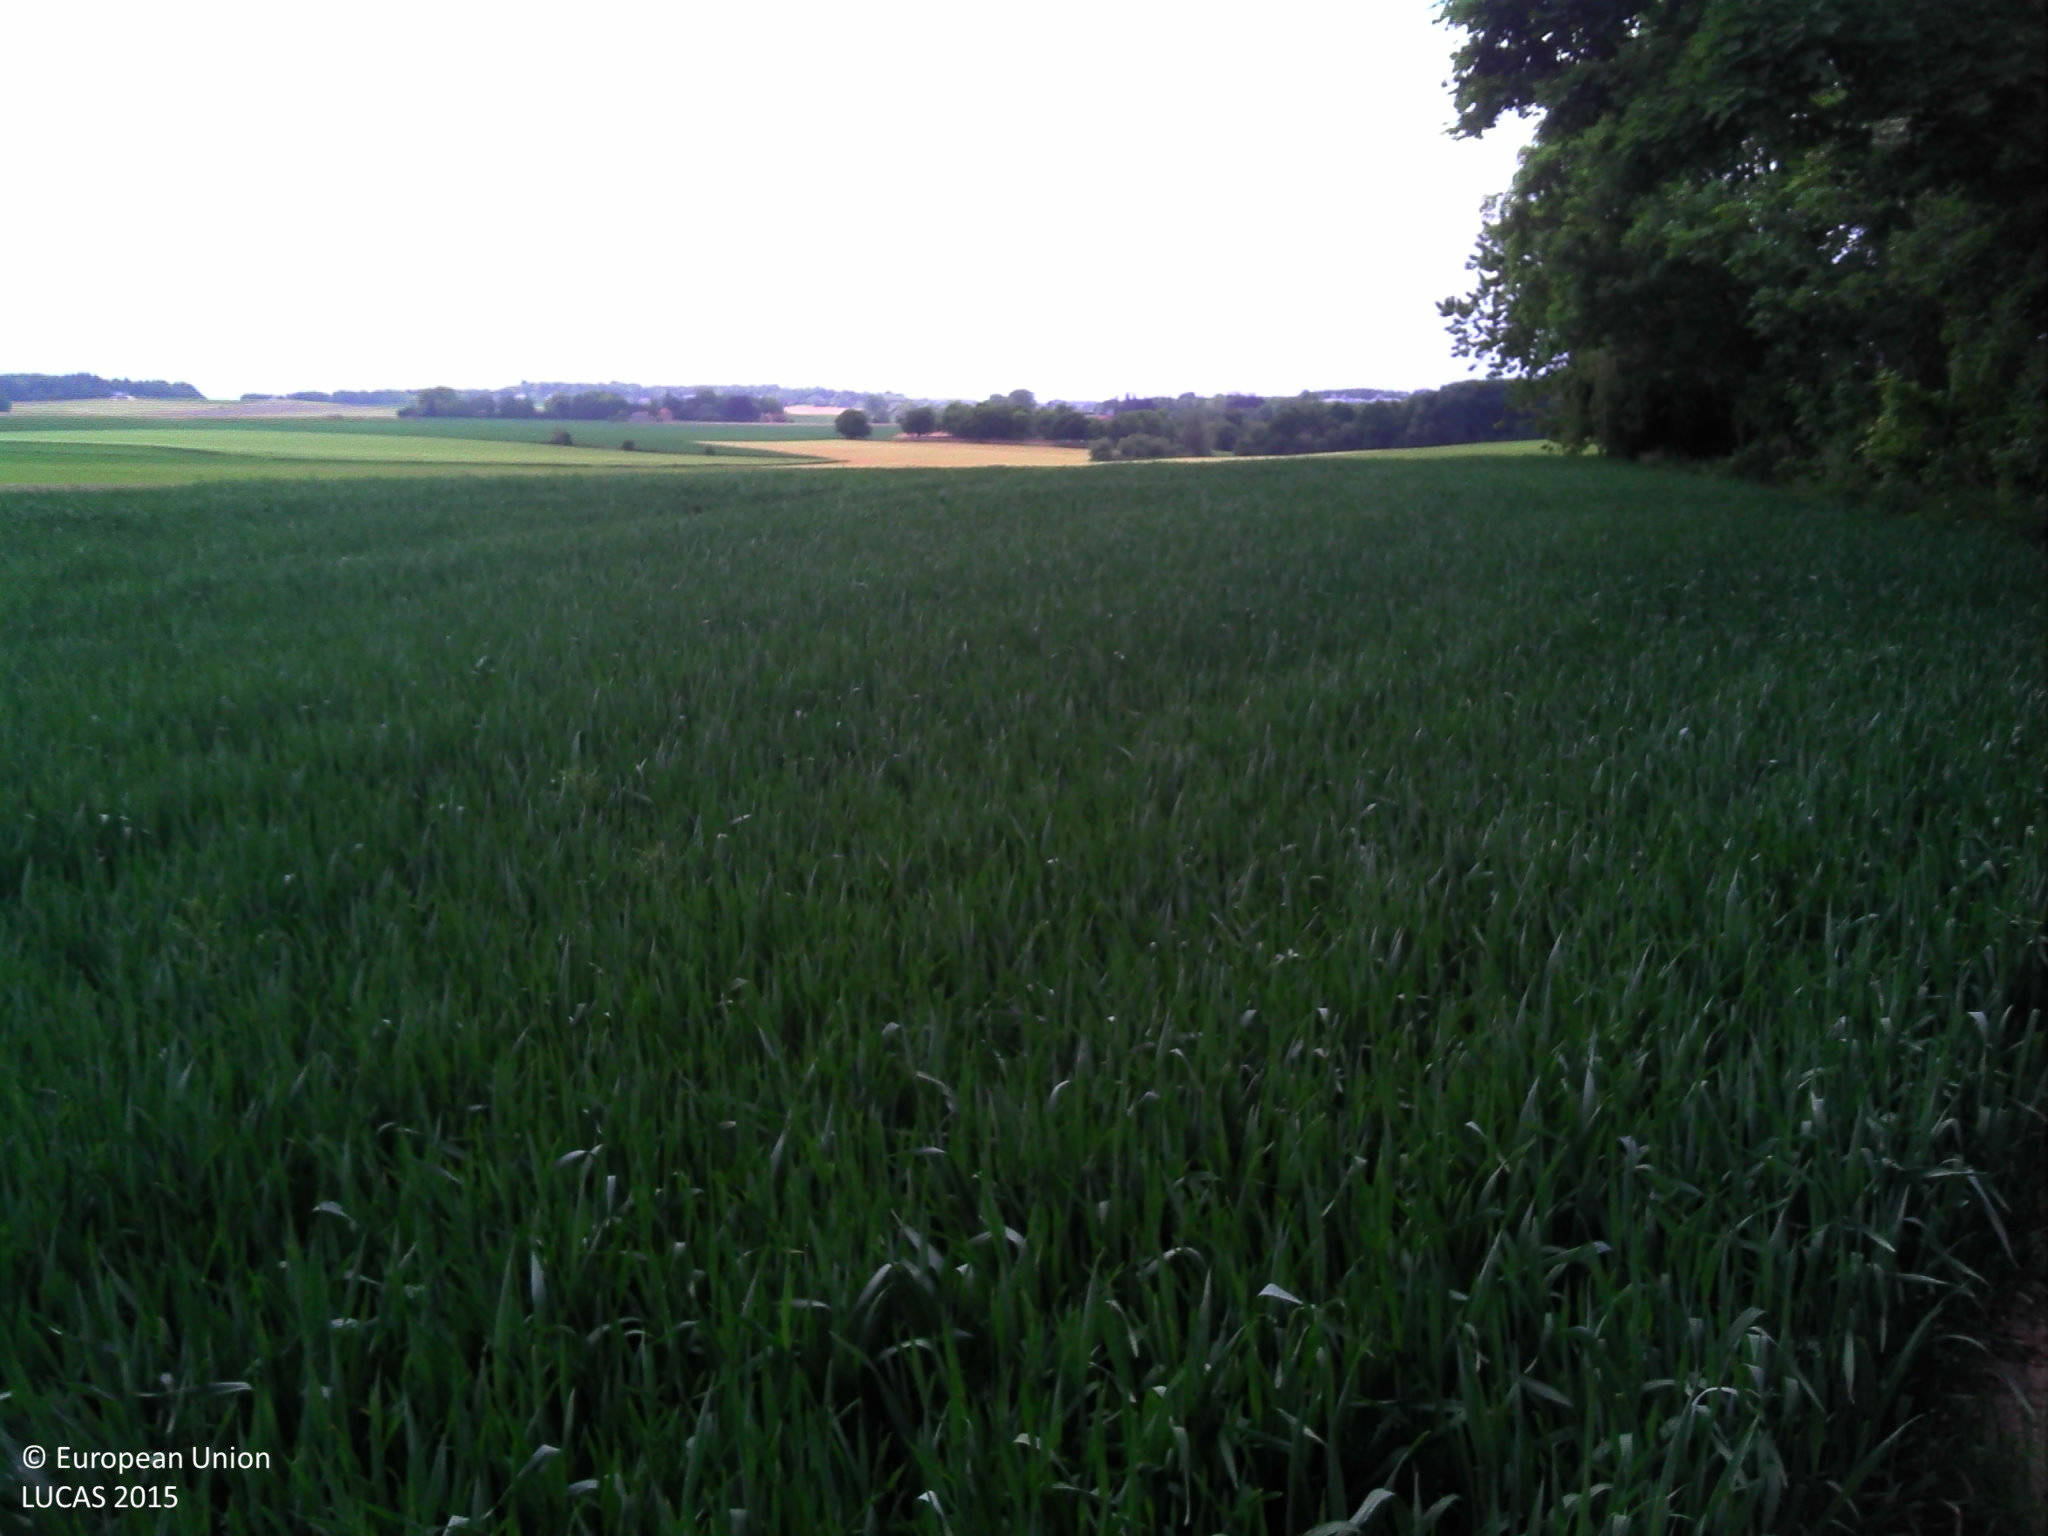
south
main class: Woodland
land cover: Broadleaved woodland
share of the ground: > 75 %
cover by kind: broadleaved forest trees 100 %
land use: Amenities, museums, leisure
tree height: > 5 m
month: May
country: BE
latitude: 50.6778
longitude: 4.4056
